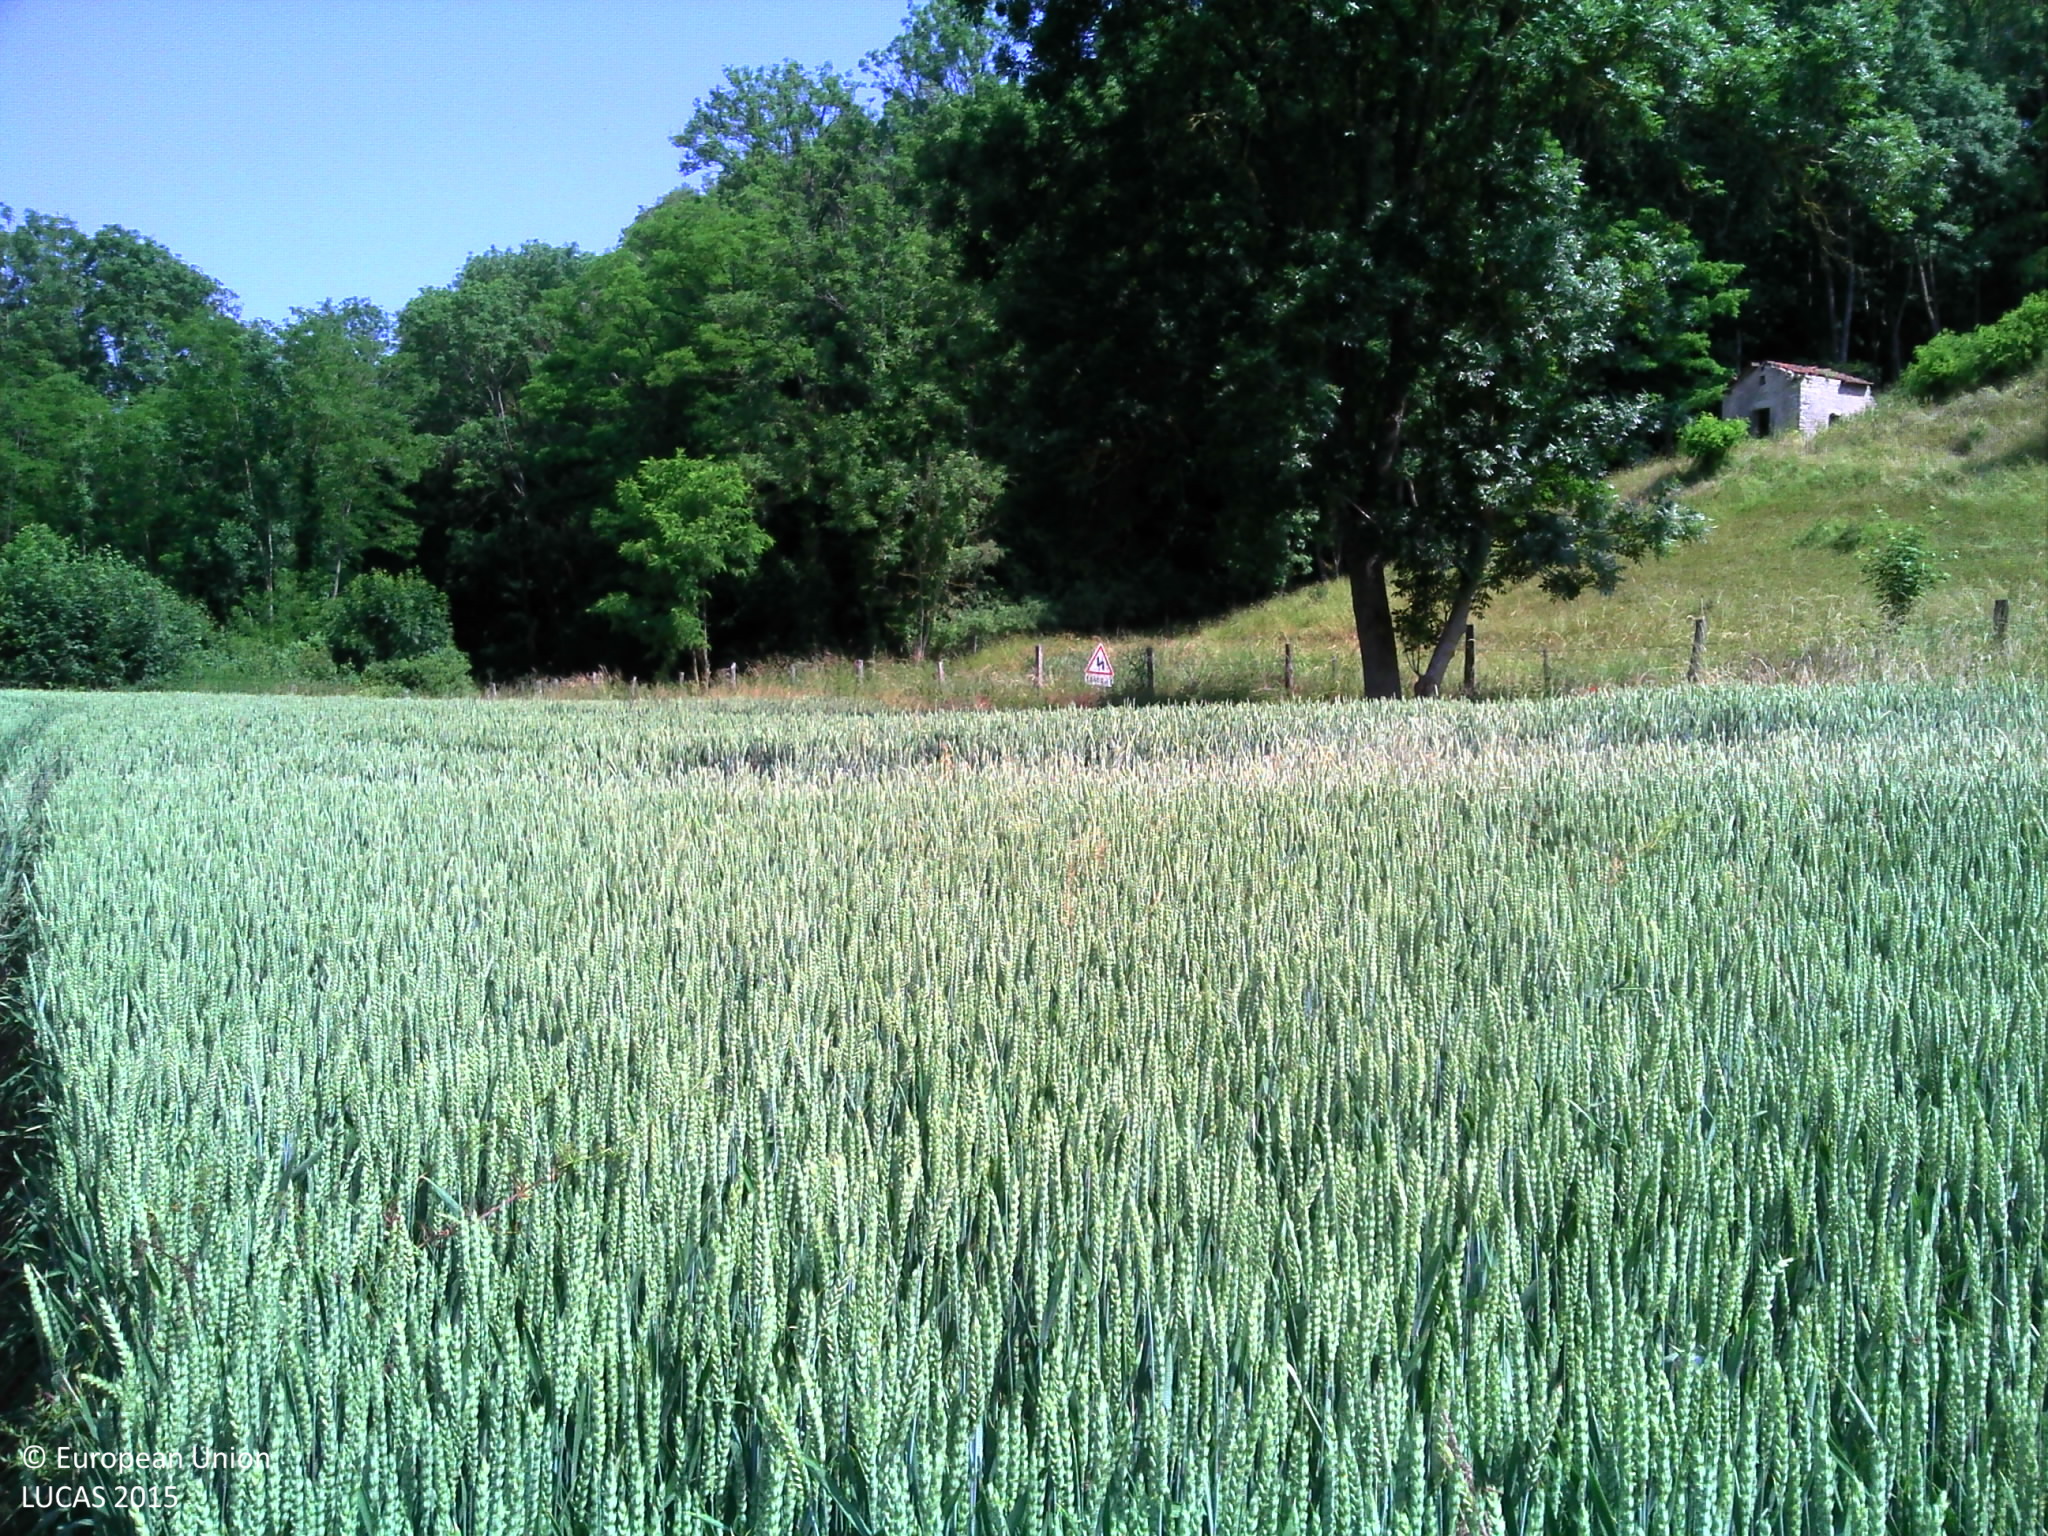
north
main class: Cropland
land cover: Common wheat
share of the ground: > 75 %
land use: Agriculture (excluding fallow land and kitchen gardens)
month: June
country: FR
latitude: 48.4859
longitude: 6.3066
